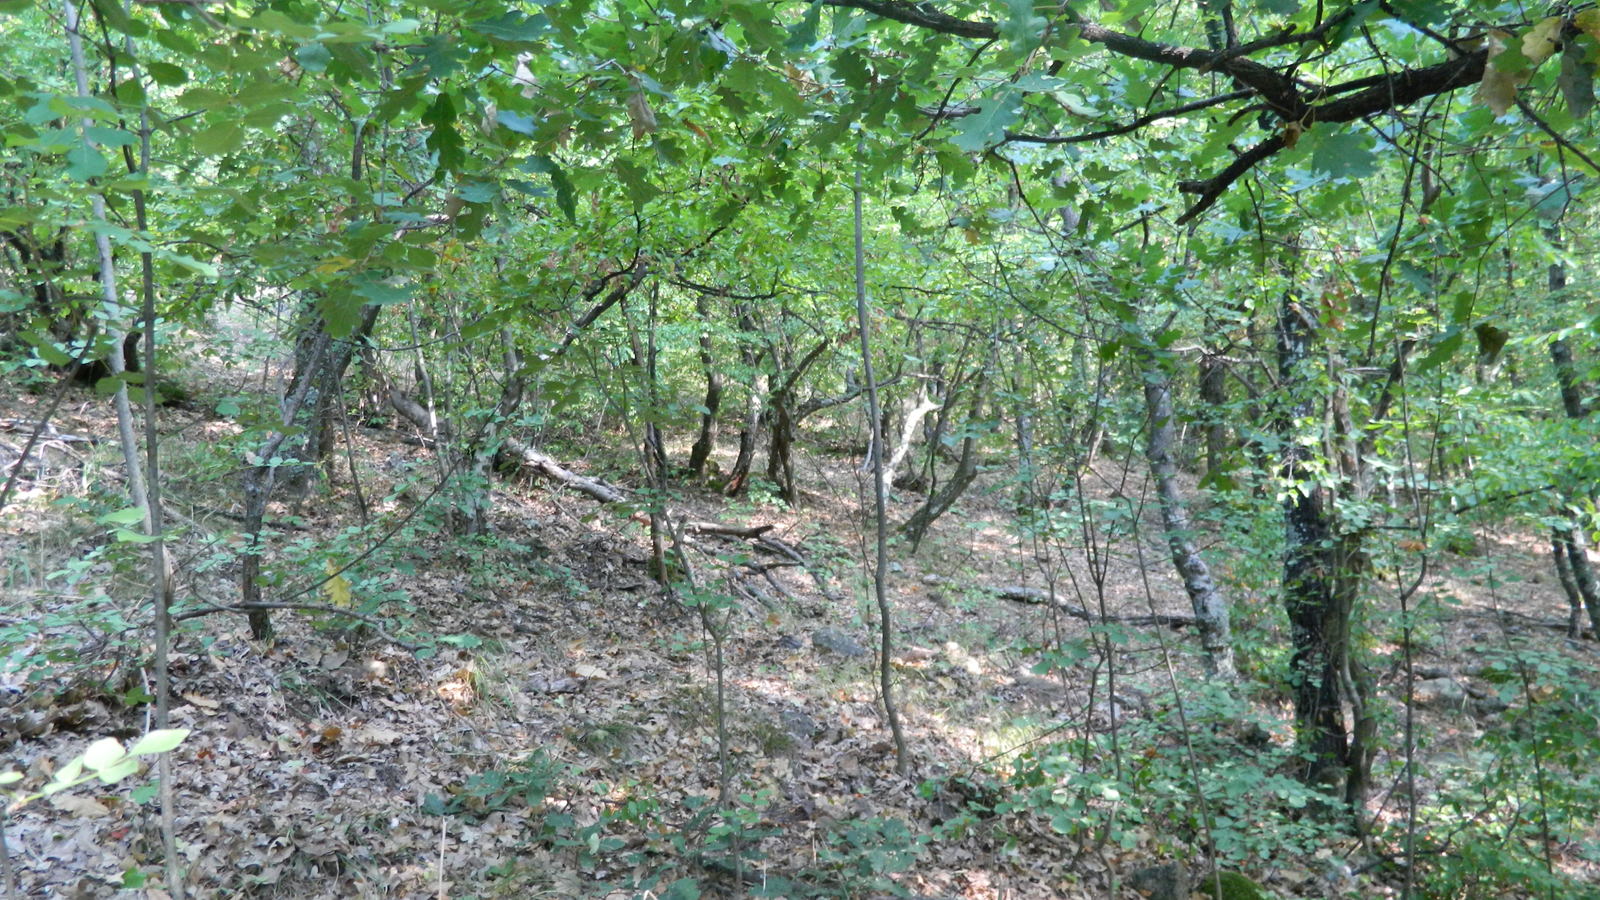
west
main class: Woodland
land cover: Broadleaved woodland
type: mesophytic deciduous forest
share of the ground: > 75 %
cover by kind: broadleaved forest trees 100 %
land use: Forestry
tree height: > 5 m
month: August
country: BG
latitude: 41.6566
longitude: 25.8334
